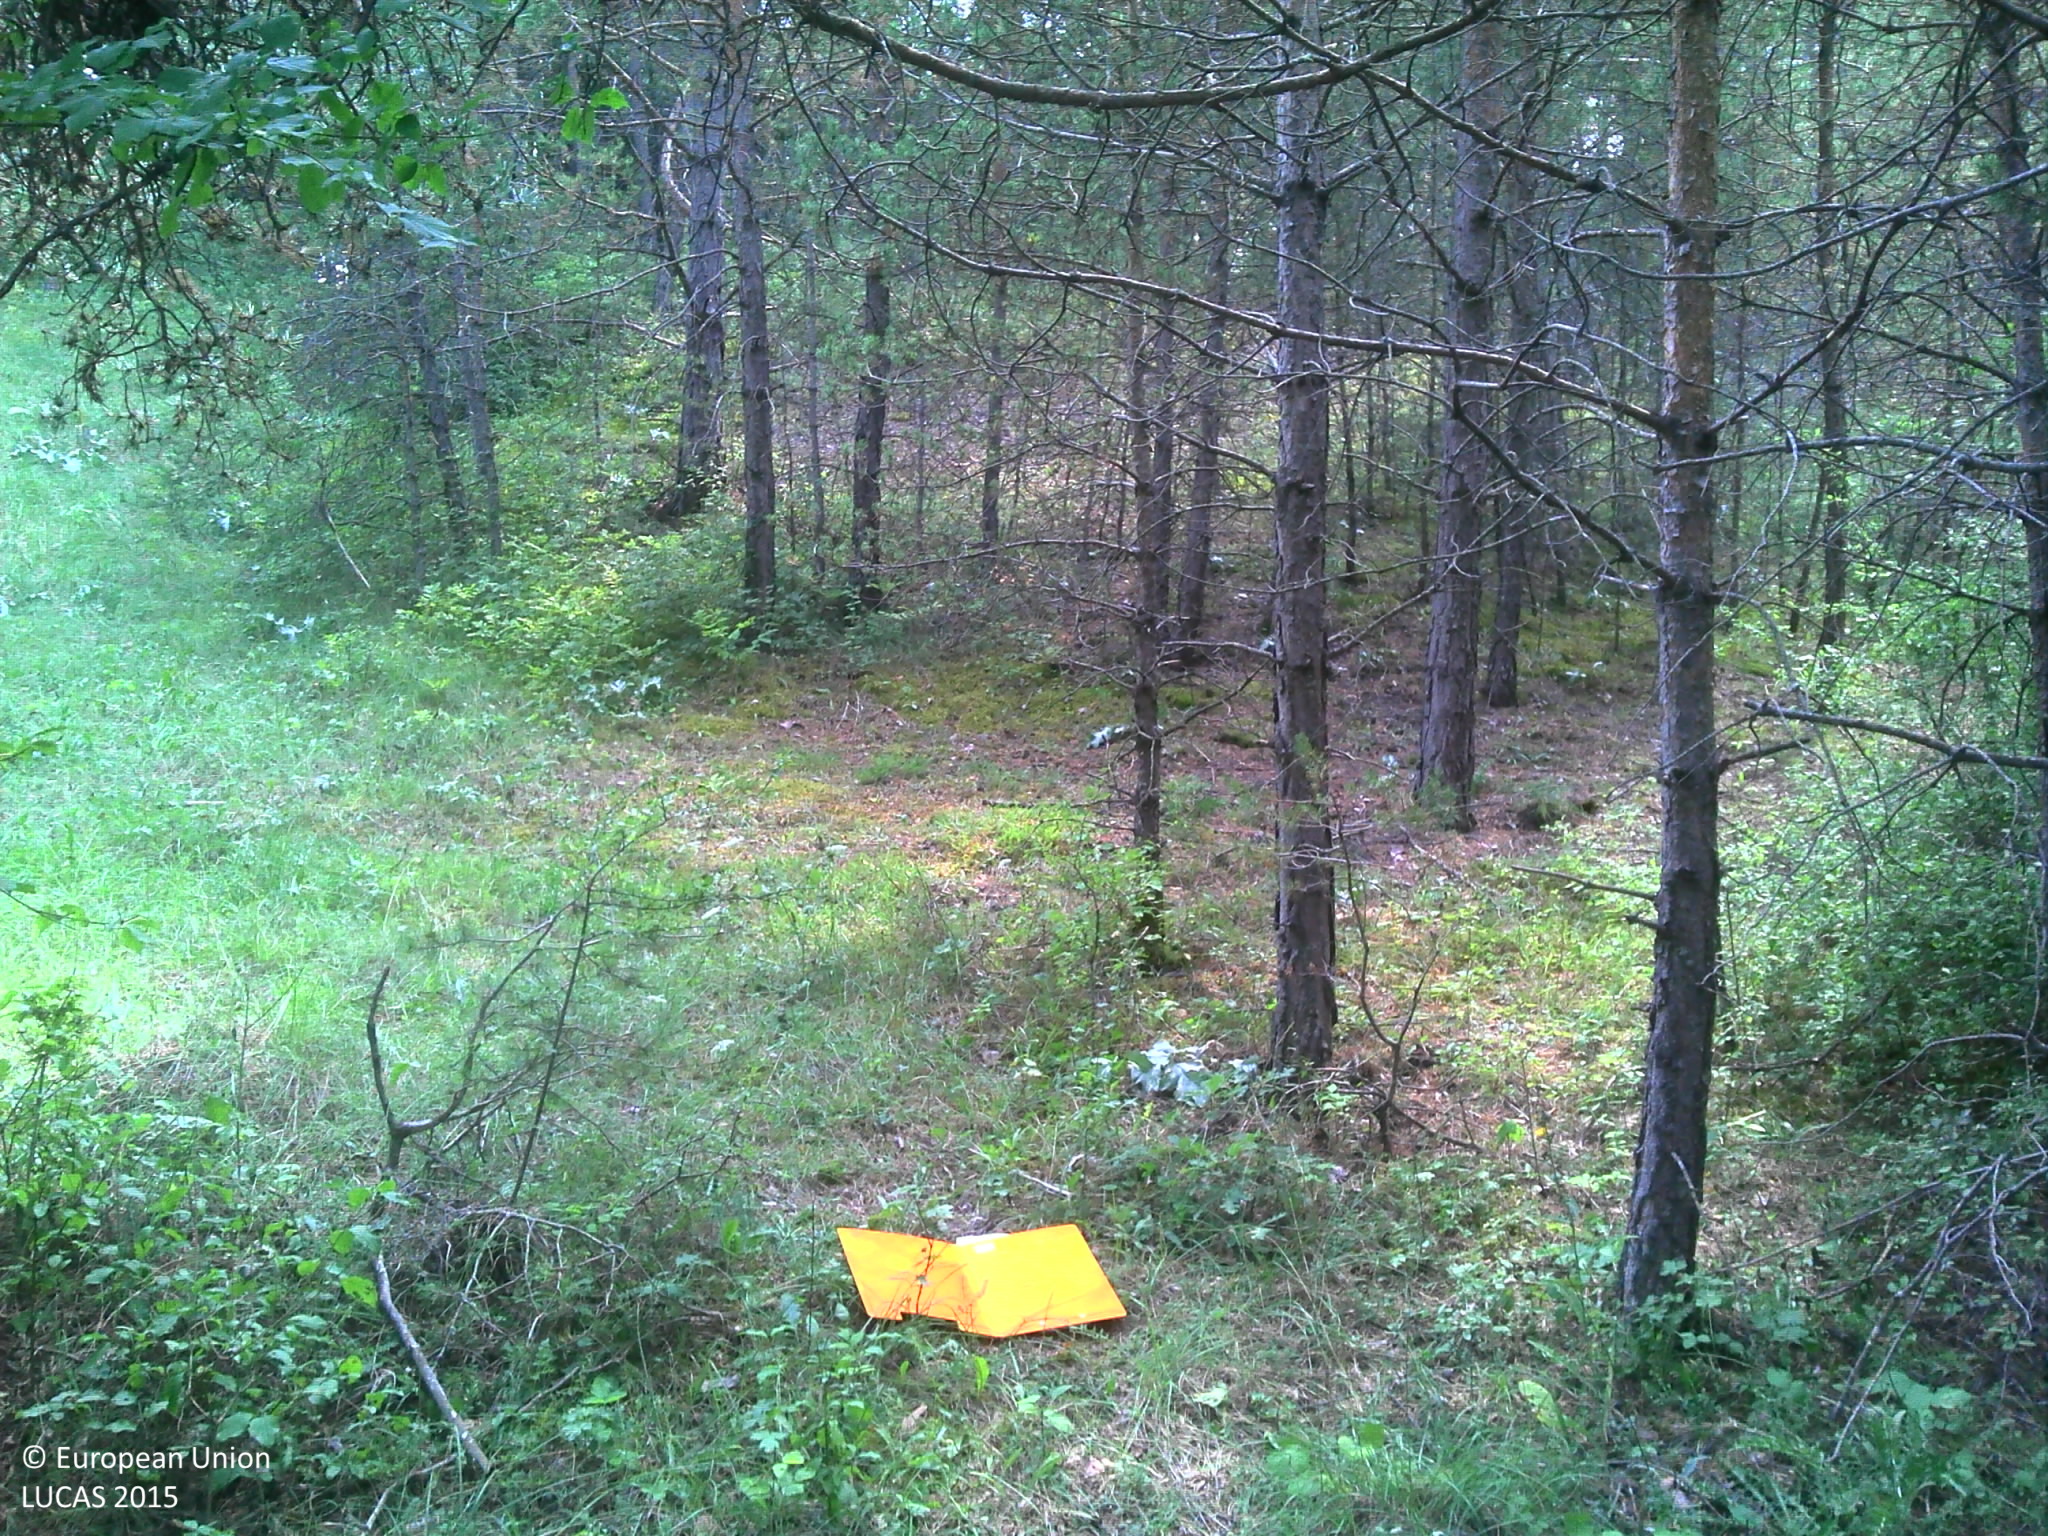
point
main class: Woodland
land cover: Pine dominated coniferous woodland
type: coniferous forest of the mediterranean region
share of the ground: > 75 %
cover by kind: coniferous forest trees 80 %, herbaceous plants 10 %, consolidated bare surface 10 %
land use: Forestry
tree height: > 5 m
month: August
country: FR
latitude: 43.9831
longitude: 6.4543
